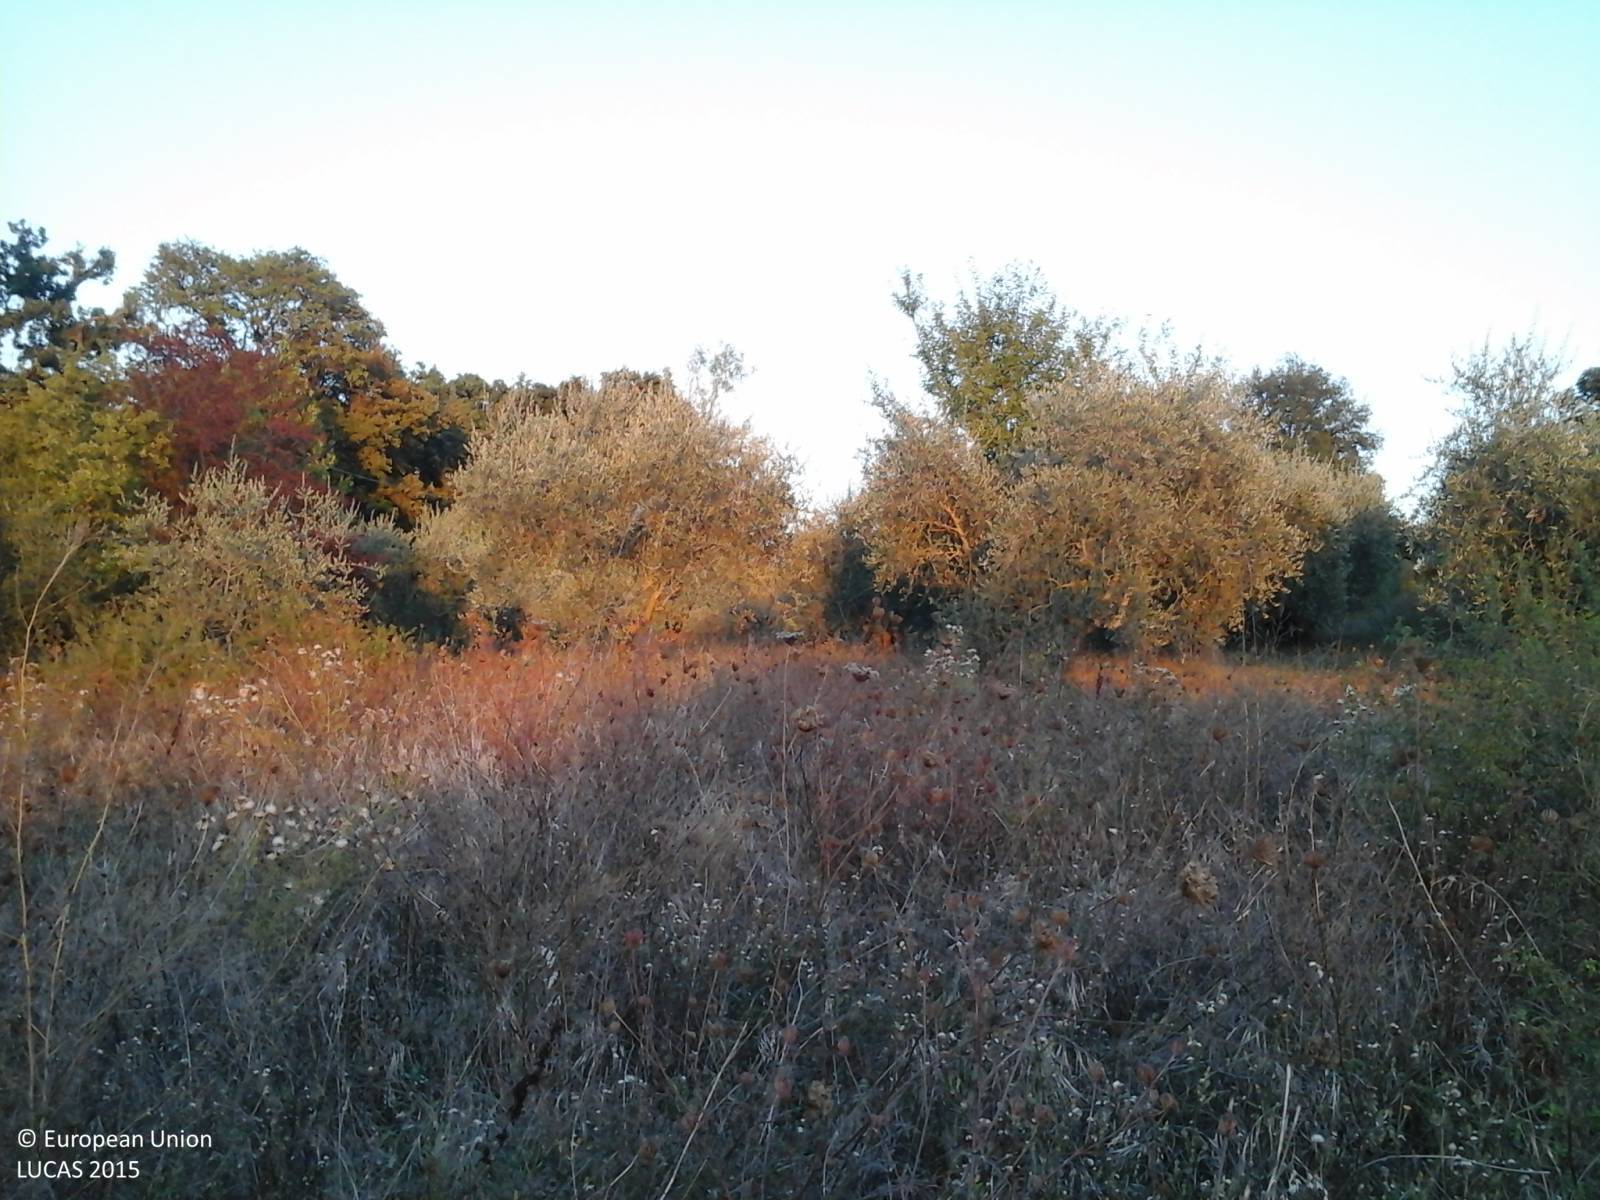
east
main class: Grassland
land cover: Spontaneously vegetated surfaces
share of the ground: > 75 %
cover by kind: herbaceous plants 100 %
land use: Abandoned areas
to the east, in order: Spontaneously vegetated surfaces; Olive groves; Grassland with sparse tree/shrub cover; Artificial constructions in urban areas; Broadleaved woodland; Durum wheat; Broadleaved woodland
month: September
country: IT
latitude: 43.0775
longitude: 12.3881
